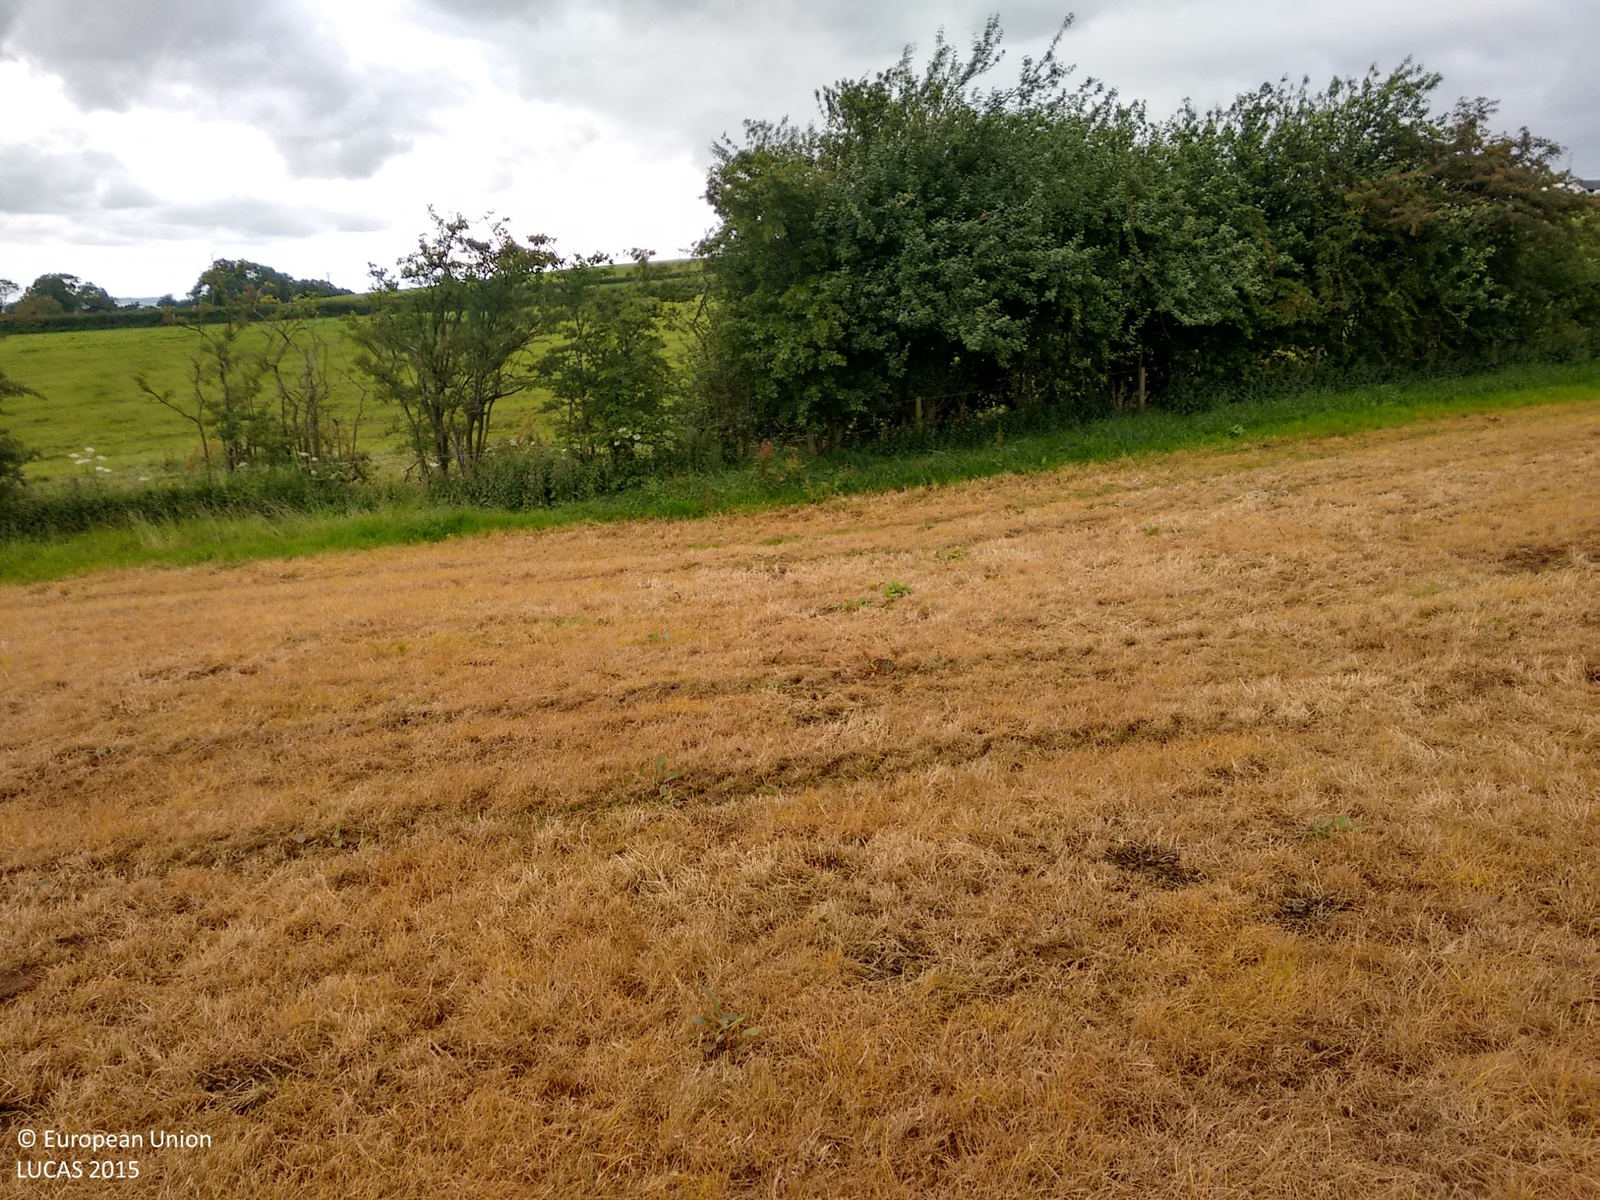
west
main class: Grassland
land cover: Grassland without tree/shrub cover
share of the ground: > 75 %
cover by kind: herbaceous plants 100 %
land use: Agriculture (excluding fallow land and kitchen gardens)
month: July
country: GB
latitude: 55.6181
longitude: -4.3064
